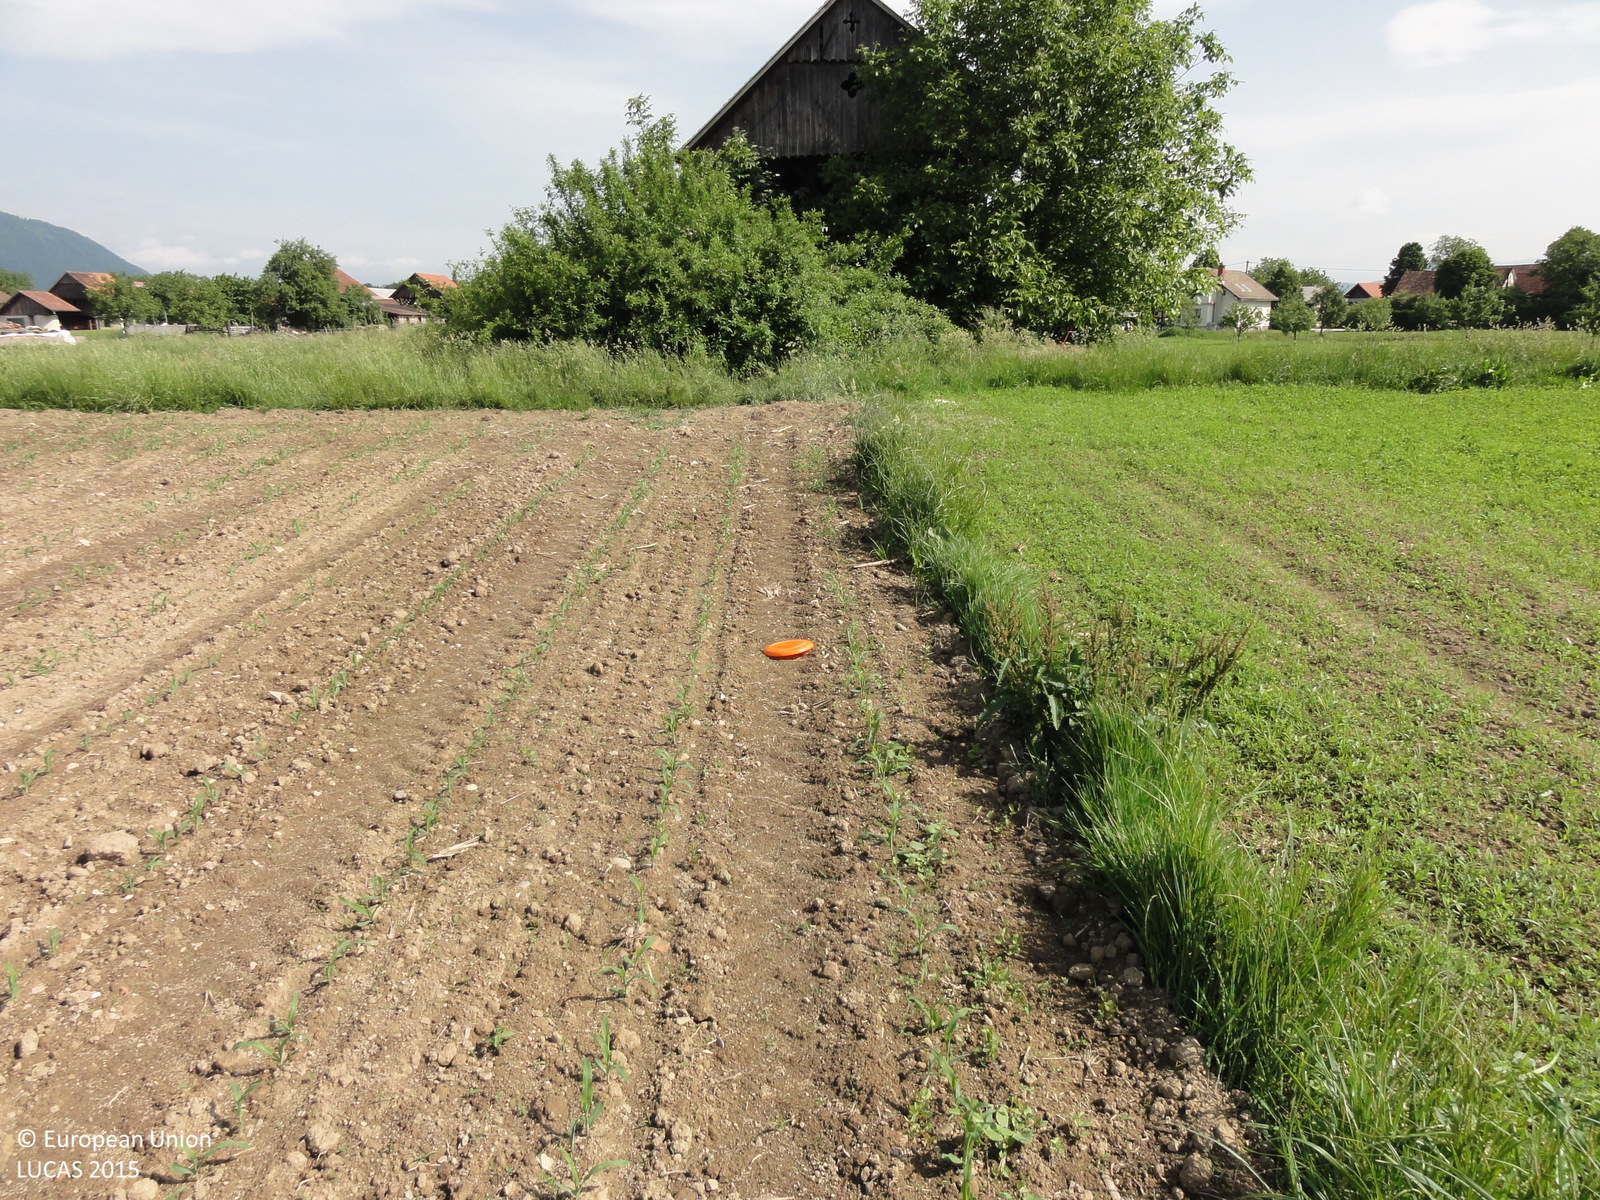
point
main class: Cropland
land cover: Maize
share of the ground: > 75 %
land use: Agriculture (excluding fallow land and kitchen gardens)
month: May
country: SI
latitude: 46.2503
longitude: 15.0432
